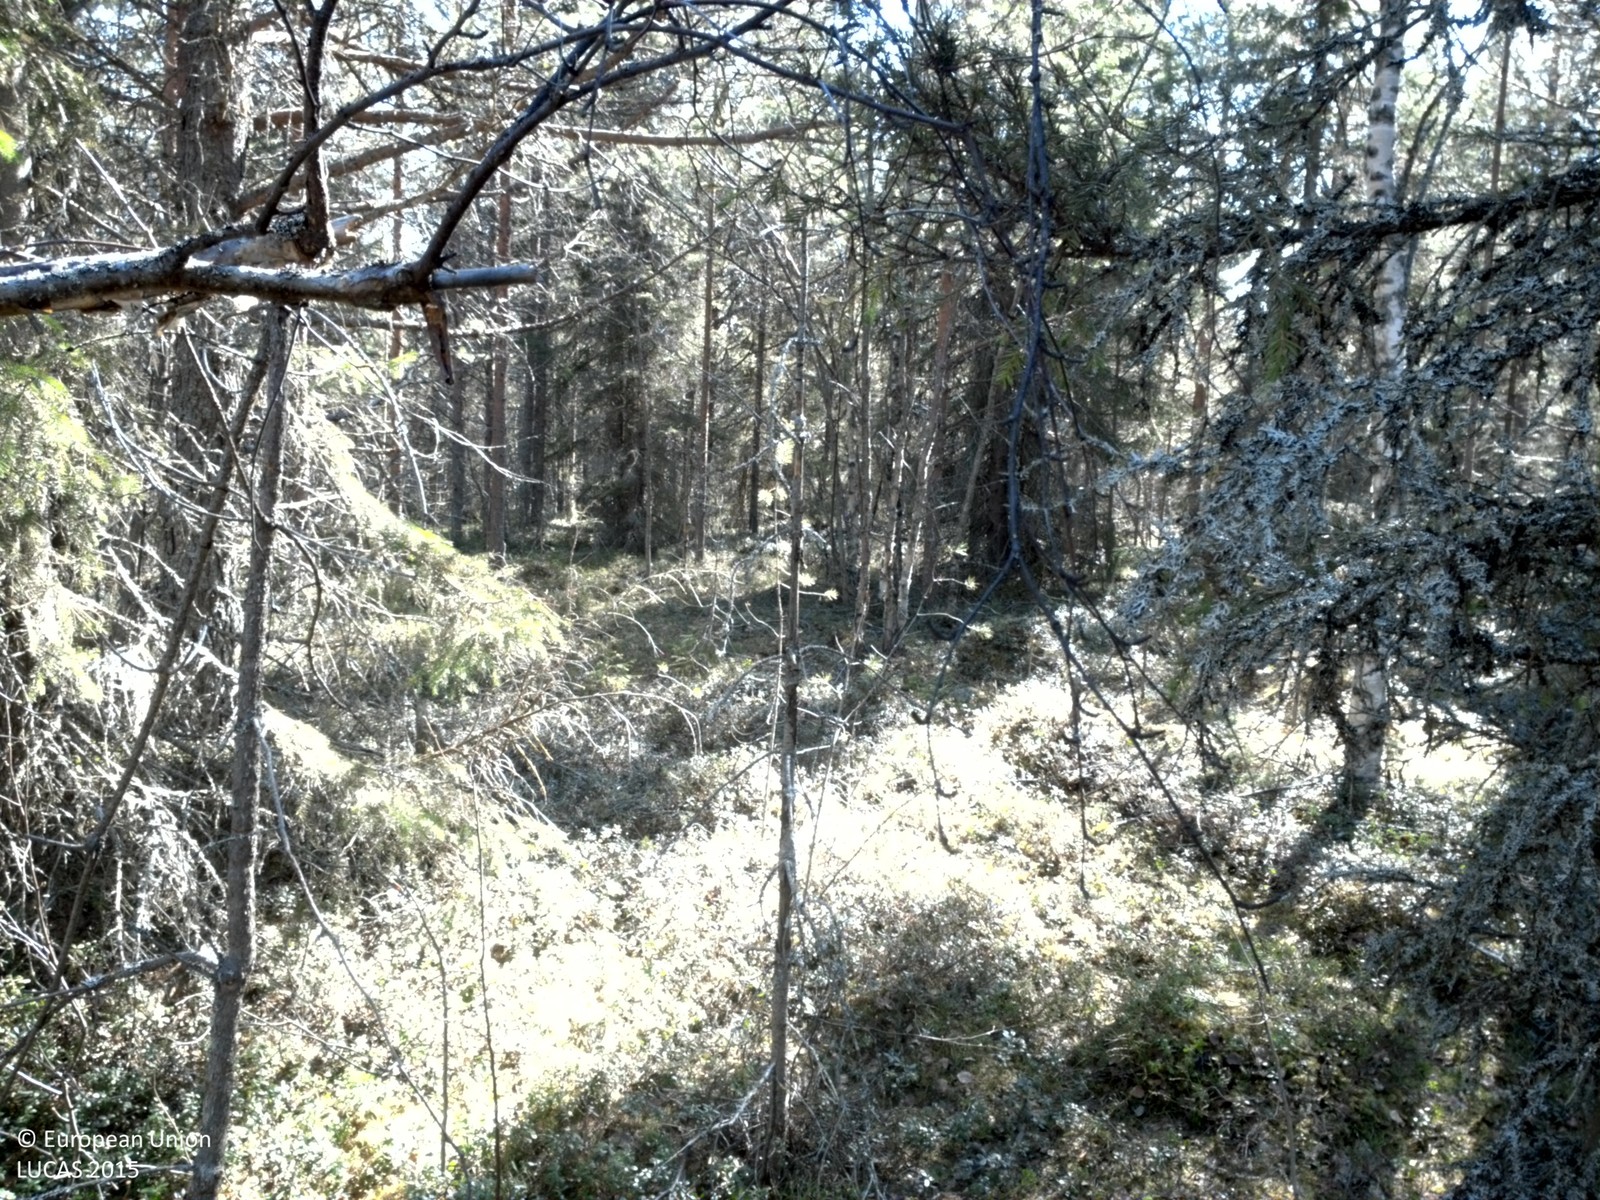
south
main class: Woodland
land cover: Pine dominated coniferous woodland
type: boreal forest
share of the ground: > 75 %
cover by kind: coniferous forest trees 80 %, shrubs 10 %, broadleaved forest trees 5 %, lichens and mosses 5 %
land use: Forestry
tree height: > 5 m
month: May
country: SE
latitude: 65.7416
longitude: 23.1426
